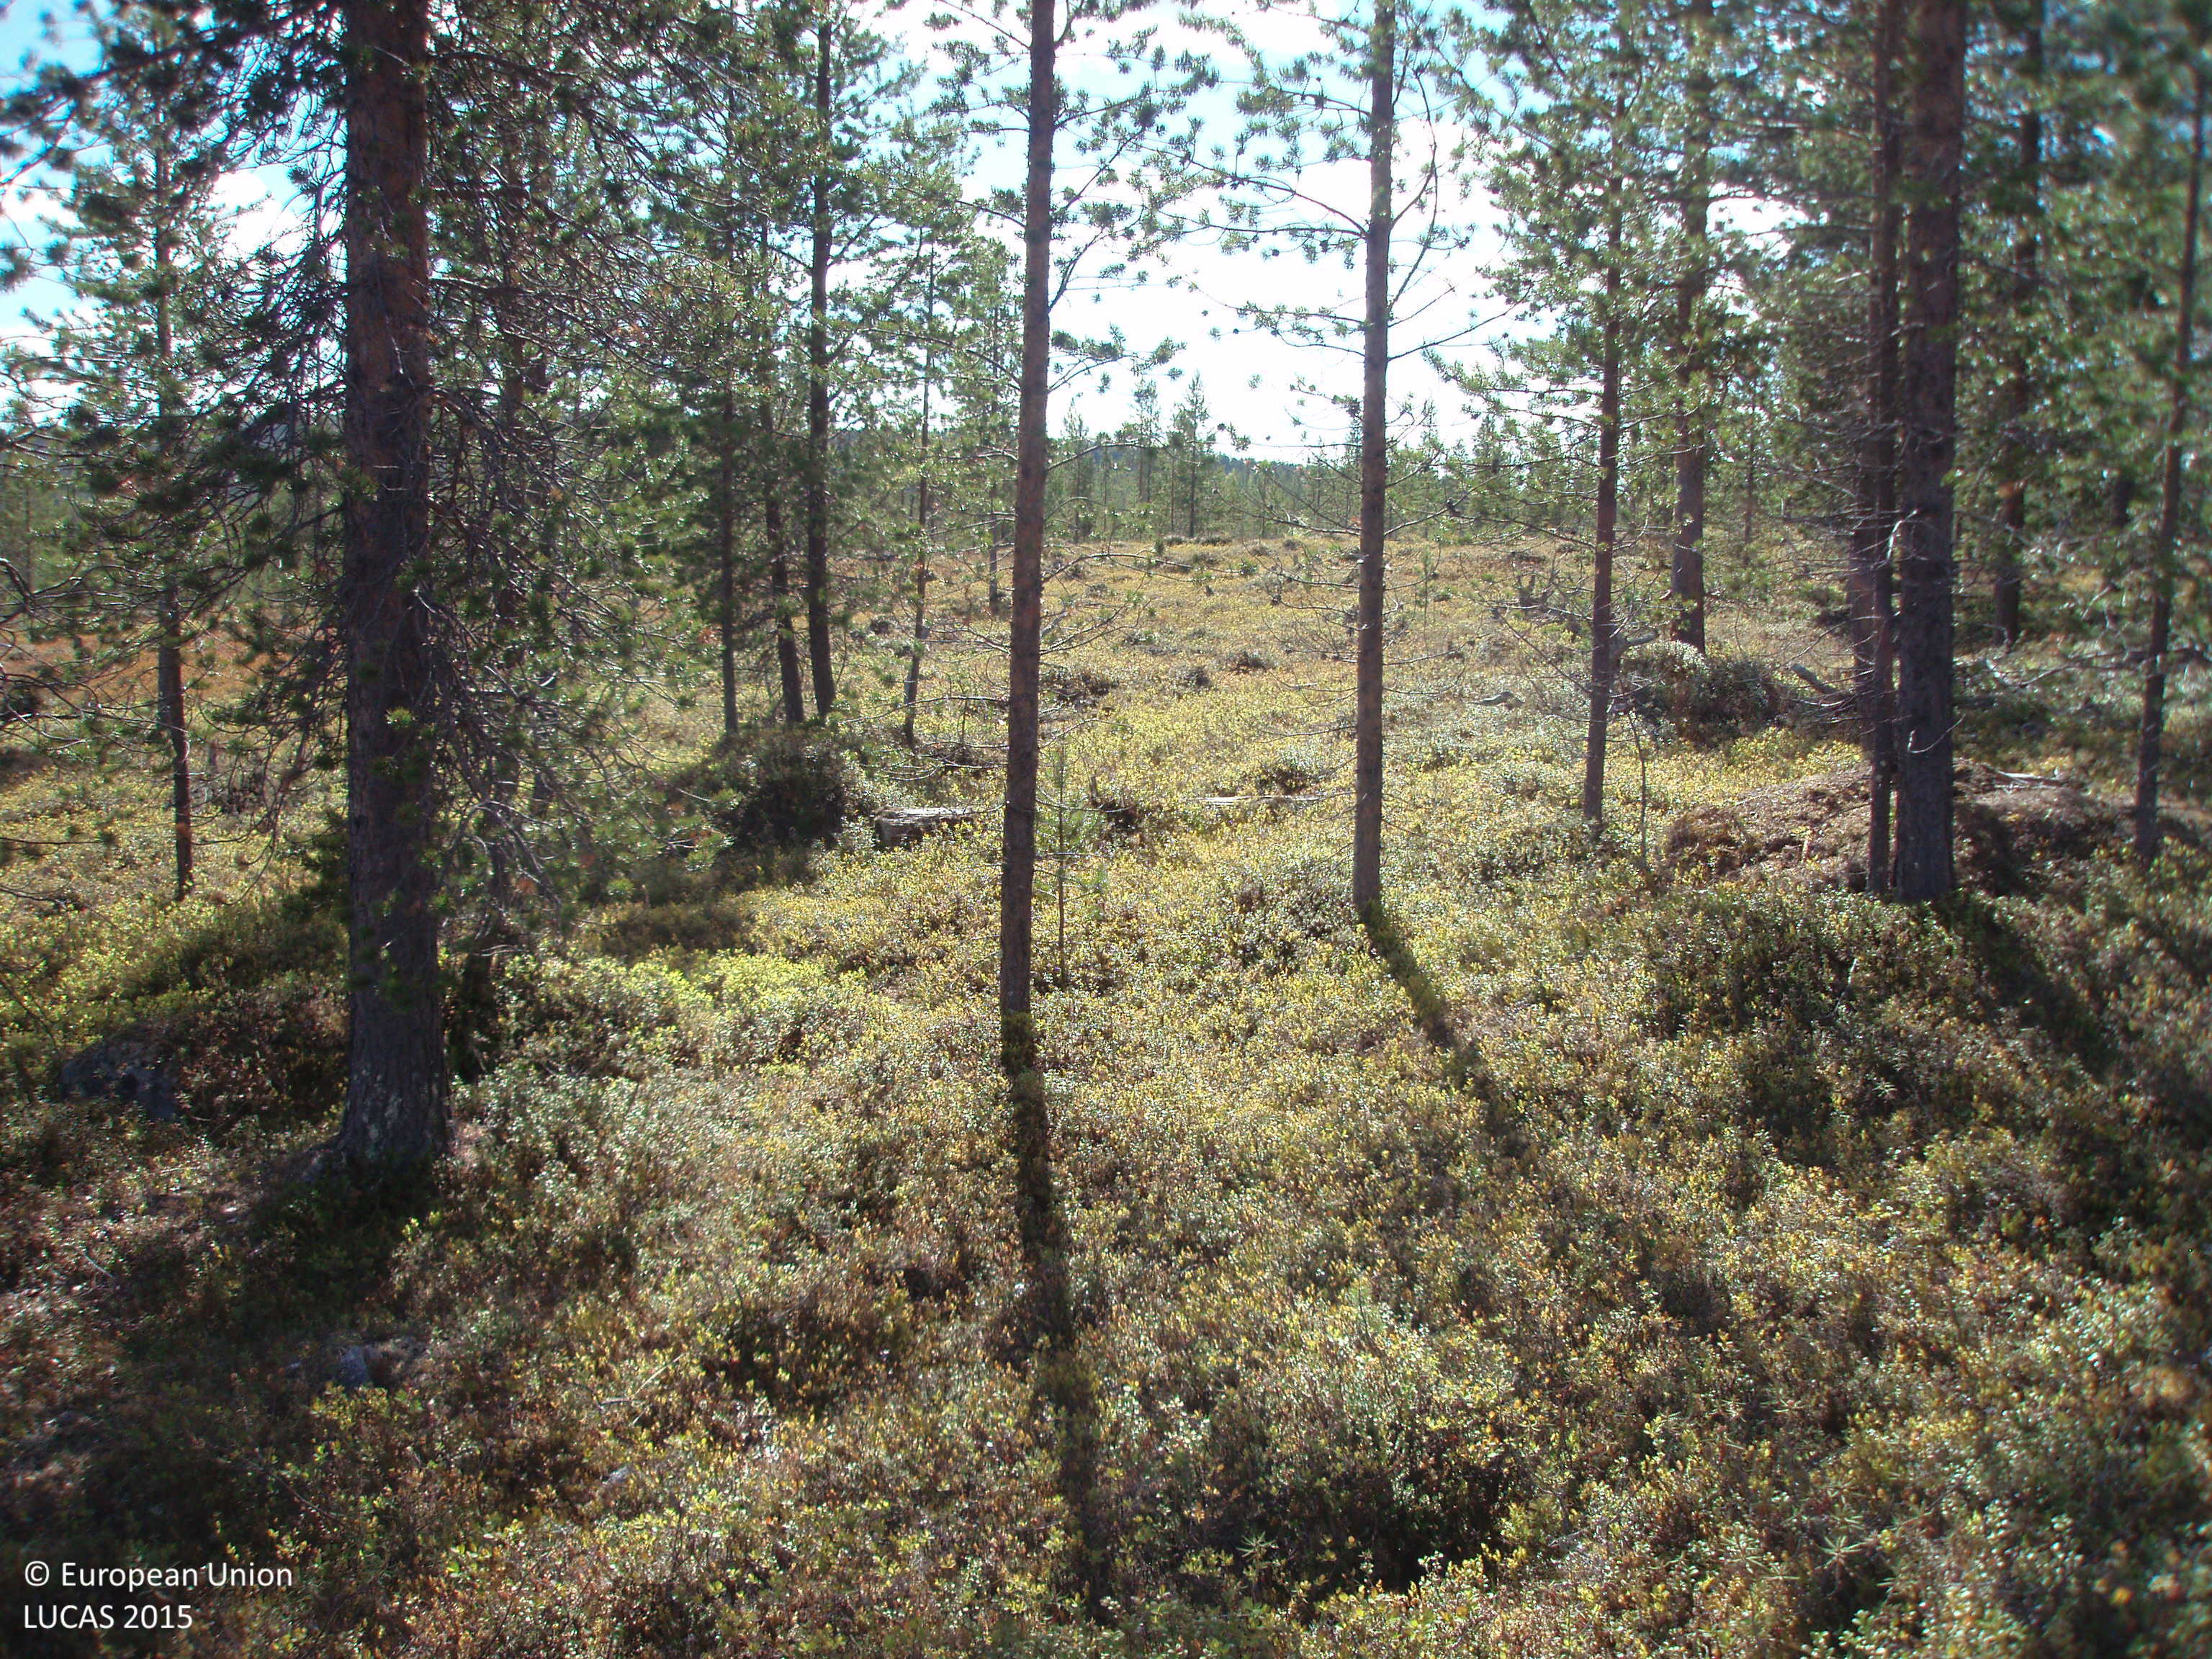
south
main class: Woodland
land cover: Pine dominated coniferous woodland
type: boreal forest
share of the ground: 25 - 50 %
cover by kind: shrubs 50 %, coniferous forest trees 35 %, lichens and mosses 10 %, broadleaved forest trees 5 %
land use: Forestry
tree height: > 5 m
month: June
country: FI
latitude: 68.6269
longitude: 28.0168
